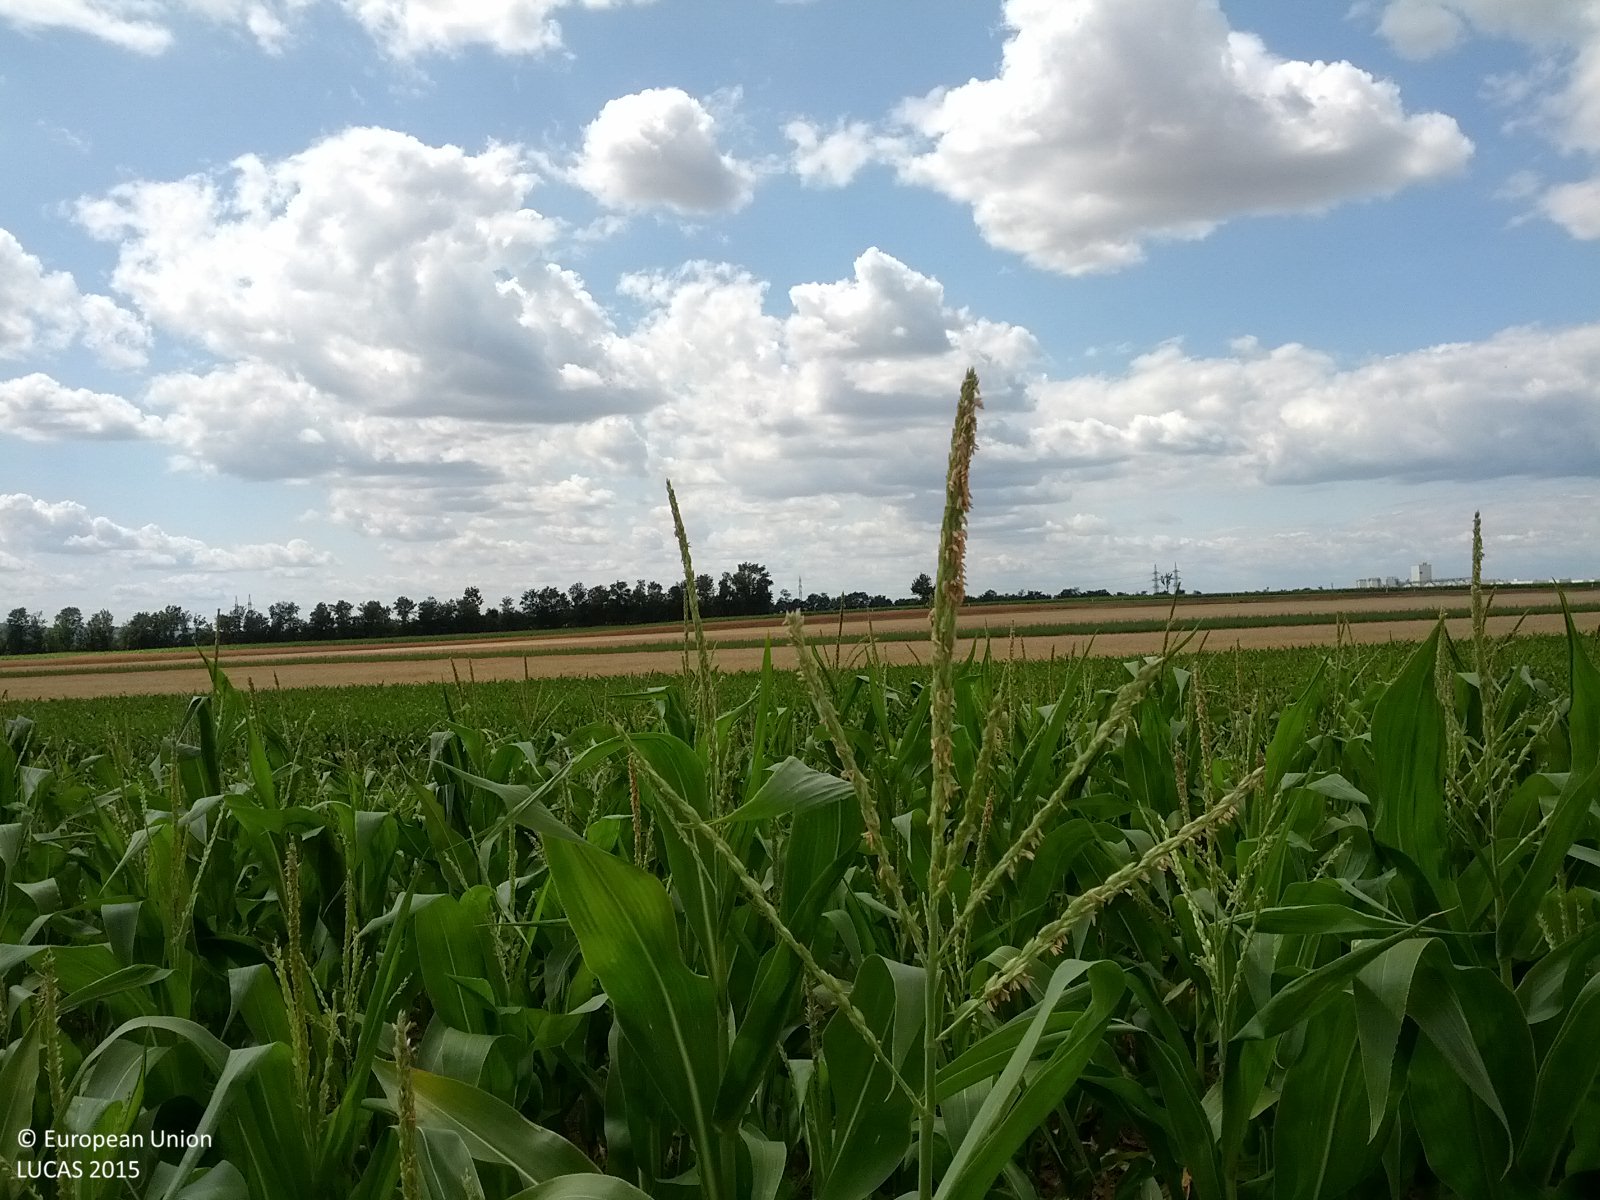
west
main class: Cropland
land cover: Maize
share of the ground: > 75 %
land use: Agriculture (excluding fallow land and kitchen gardens)
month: July
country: AT
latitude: 48.7112
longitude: 16.2979
